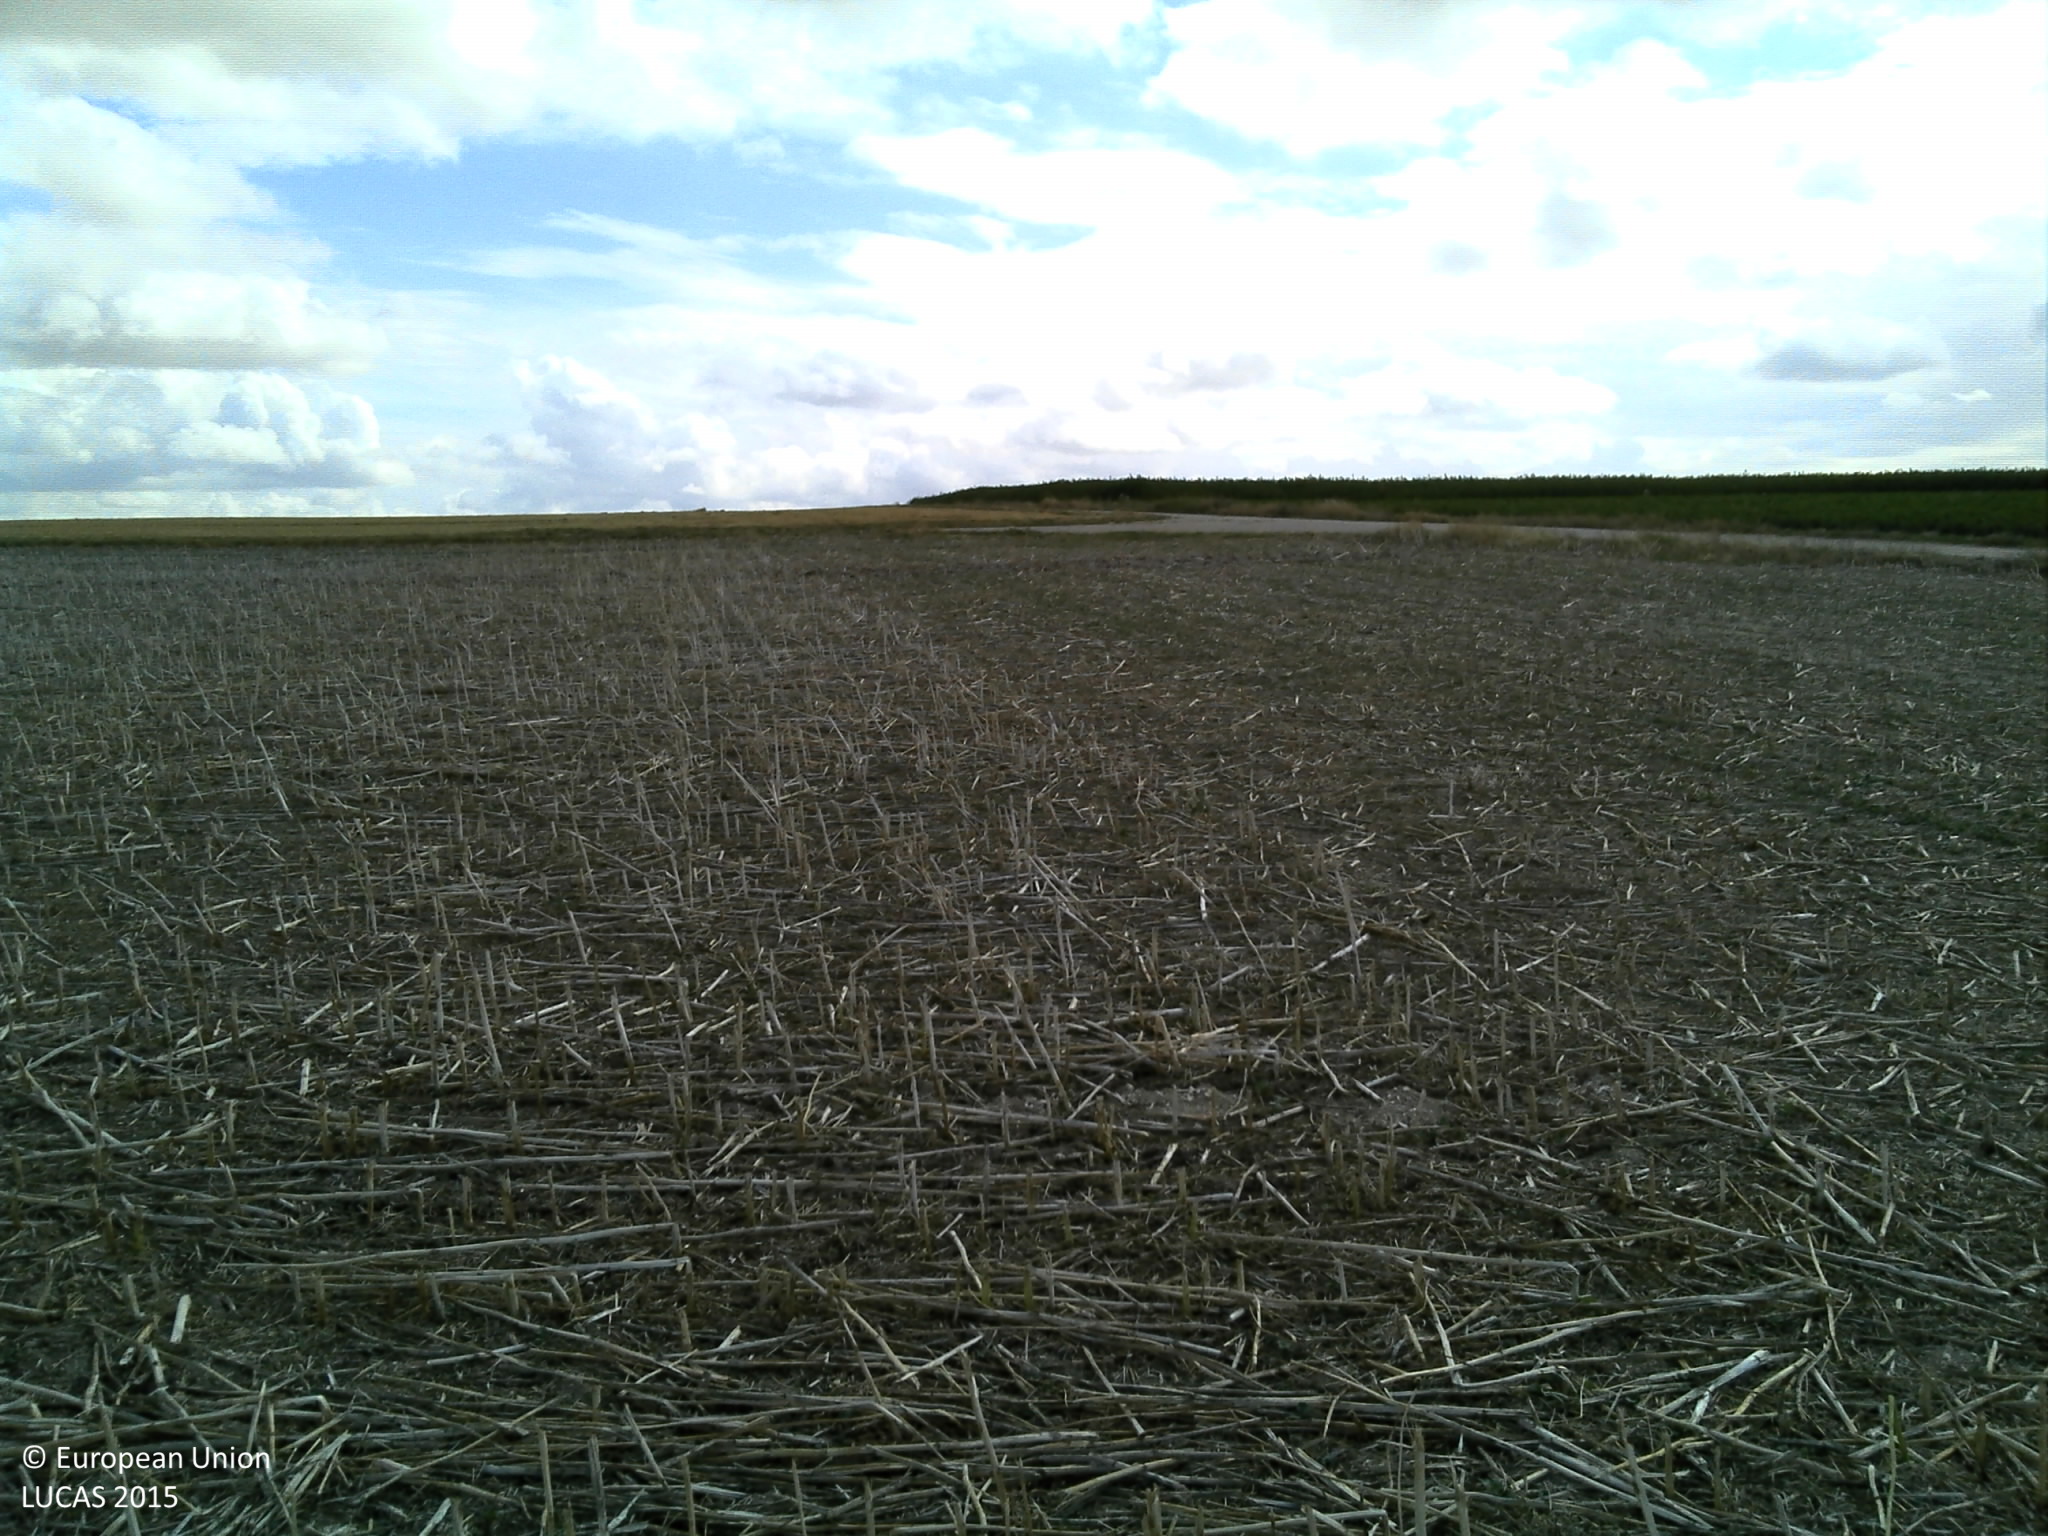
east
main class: Cropland
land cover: Rape and turnip rape
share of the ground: > 75 %
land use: Agriculture (excluding fallow land and kitchen gardens)
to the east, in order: Rape and turnip rape; Grass margins; Tracks; Grass margins; Common wheat; Grass margins; Tracks; Grass margins; Common wheat
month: August
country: FR
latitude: 48.7406
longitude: 4.2441
